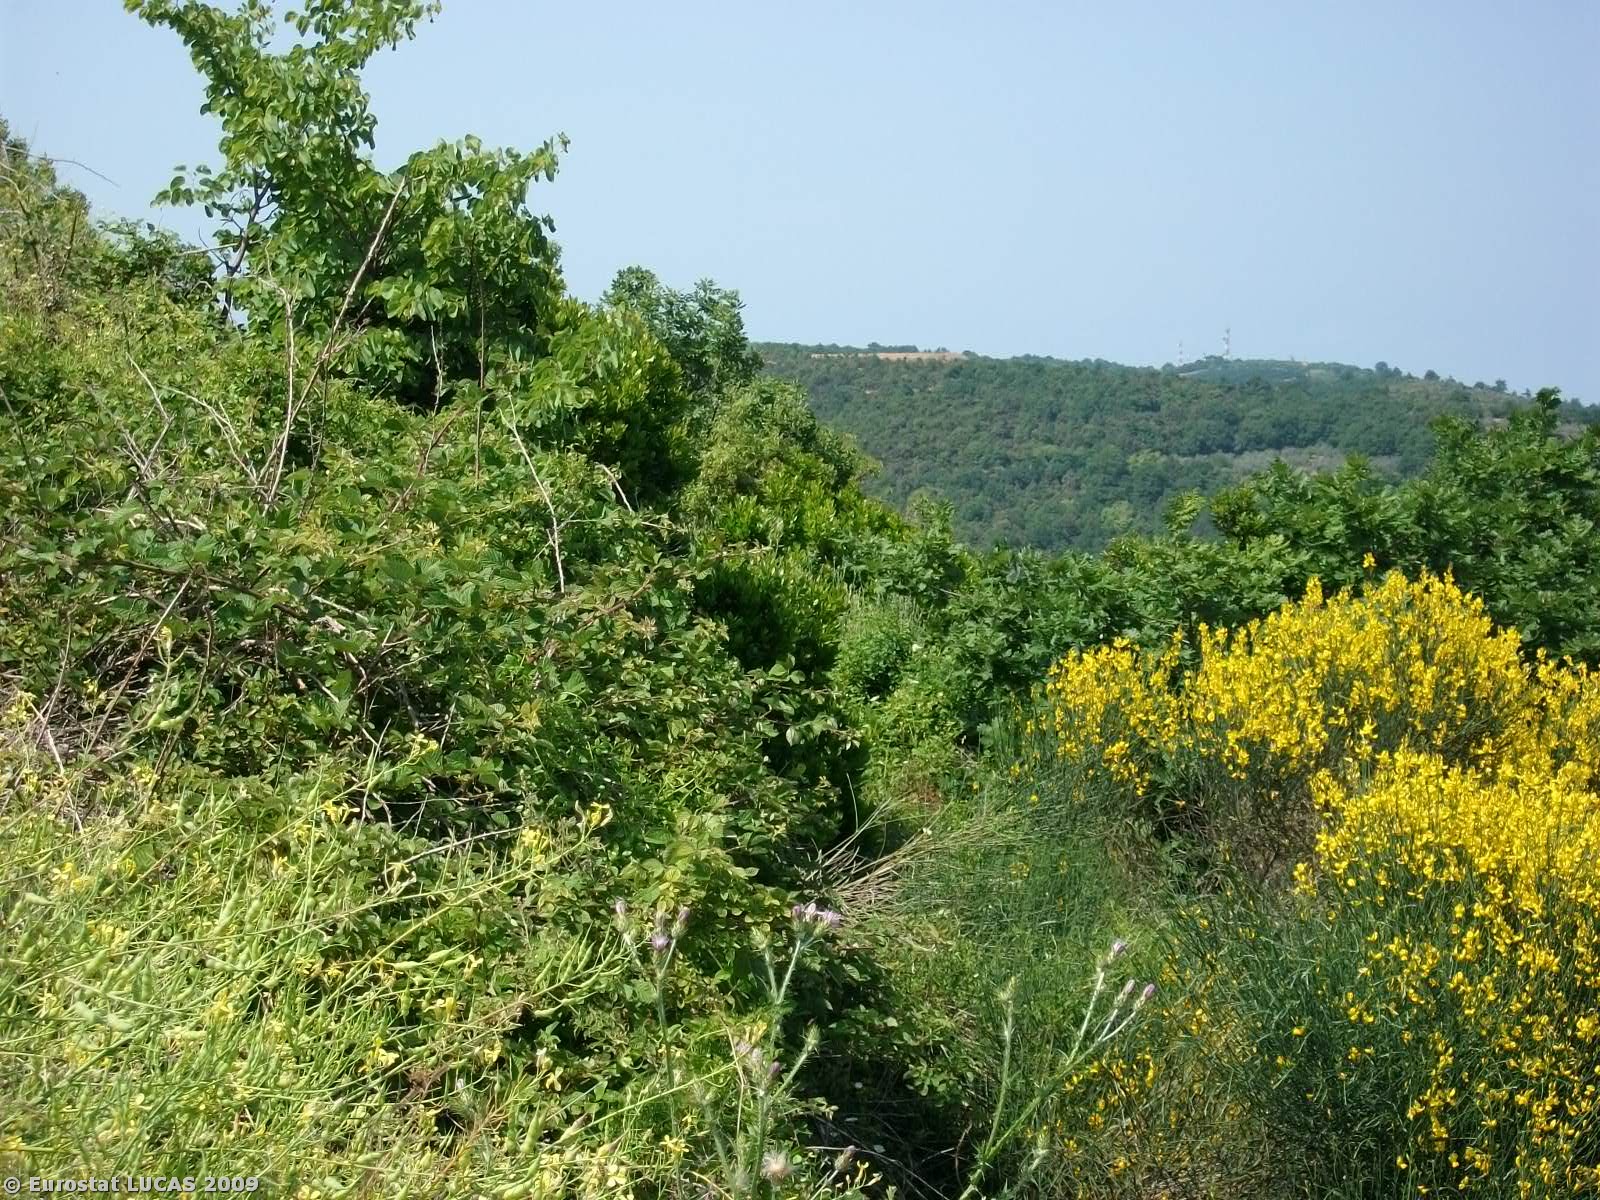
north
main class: Woodland
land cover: Broadleaved woodland
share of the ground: > 75 %
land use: Forestry
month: May
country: GR
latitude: 39.7516
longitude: 22.8217
